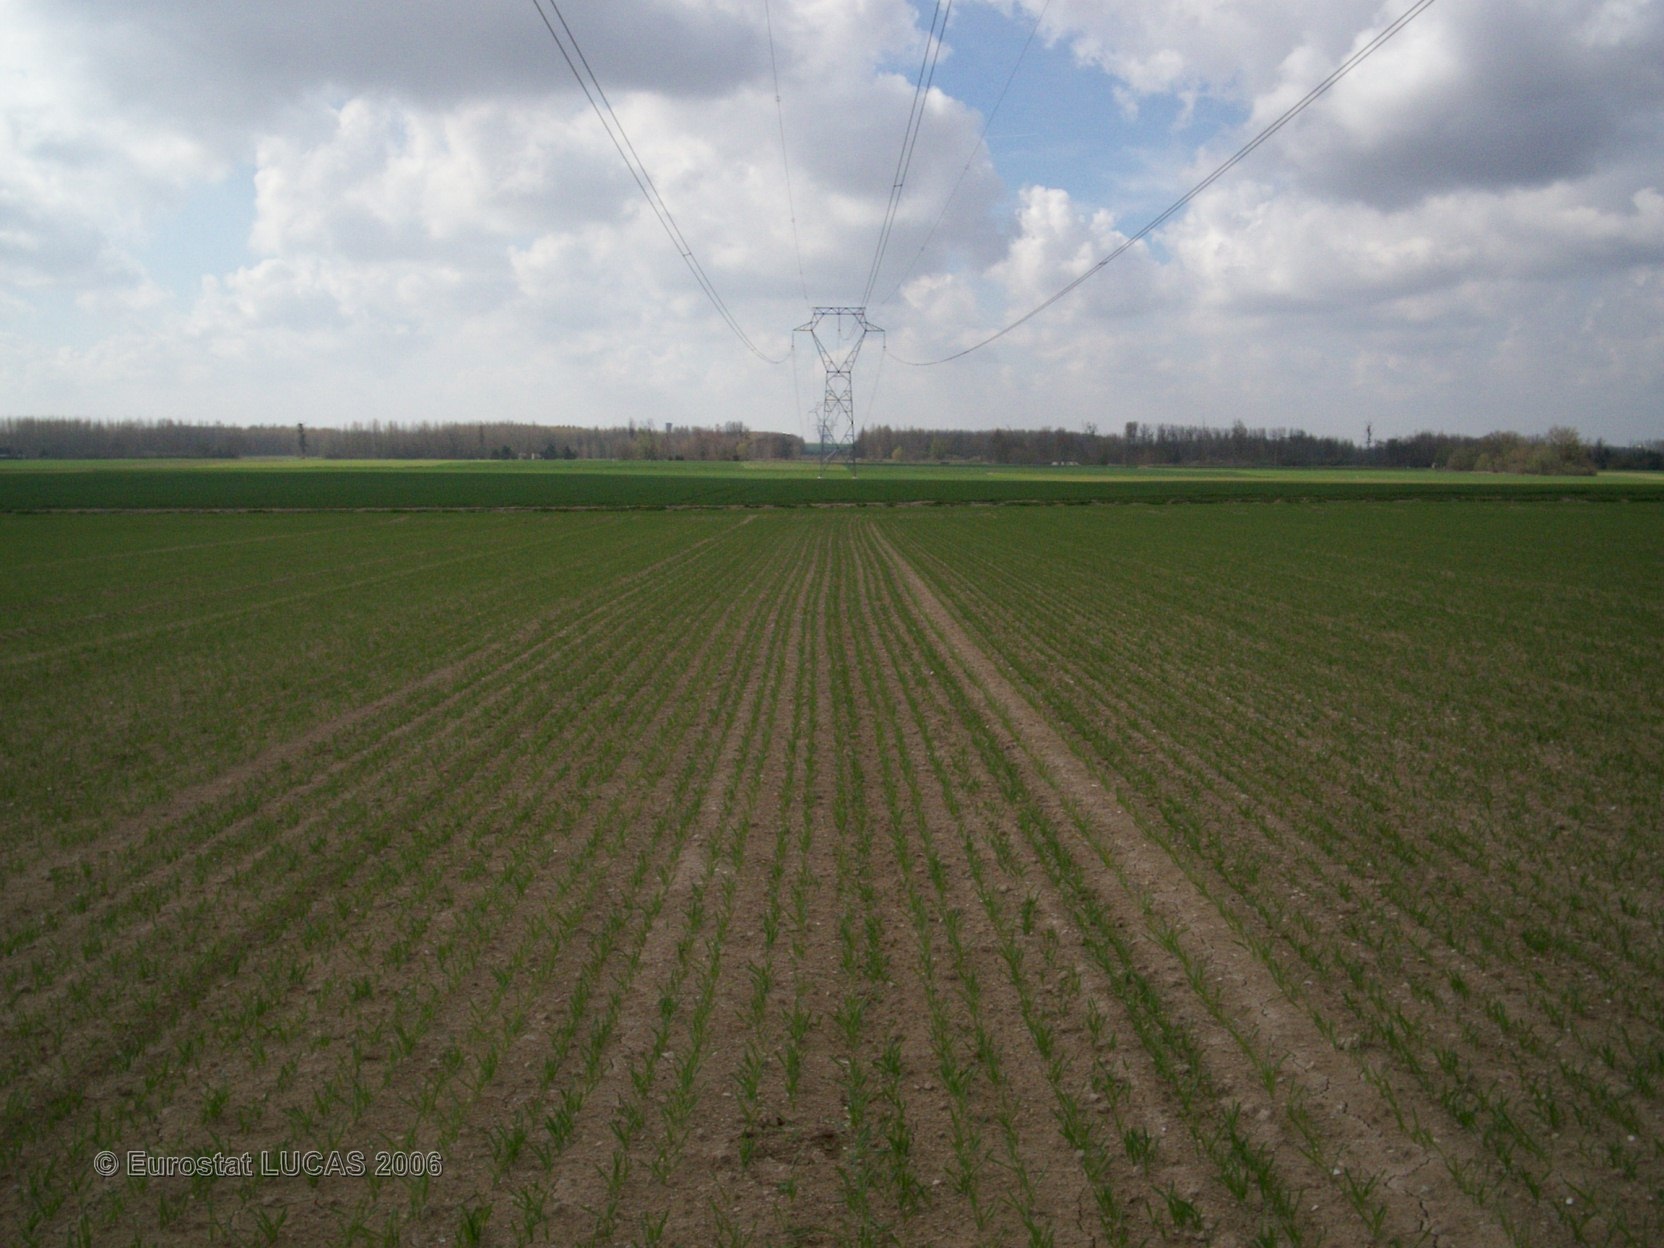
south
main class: Cropland
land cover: Barley
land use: Agriculture (excluding fallow land and kitchen gardens)
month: April
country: FR
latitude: 48.5799
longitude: 3.9363
